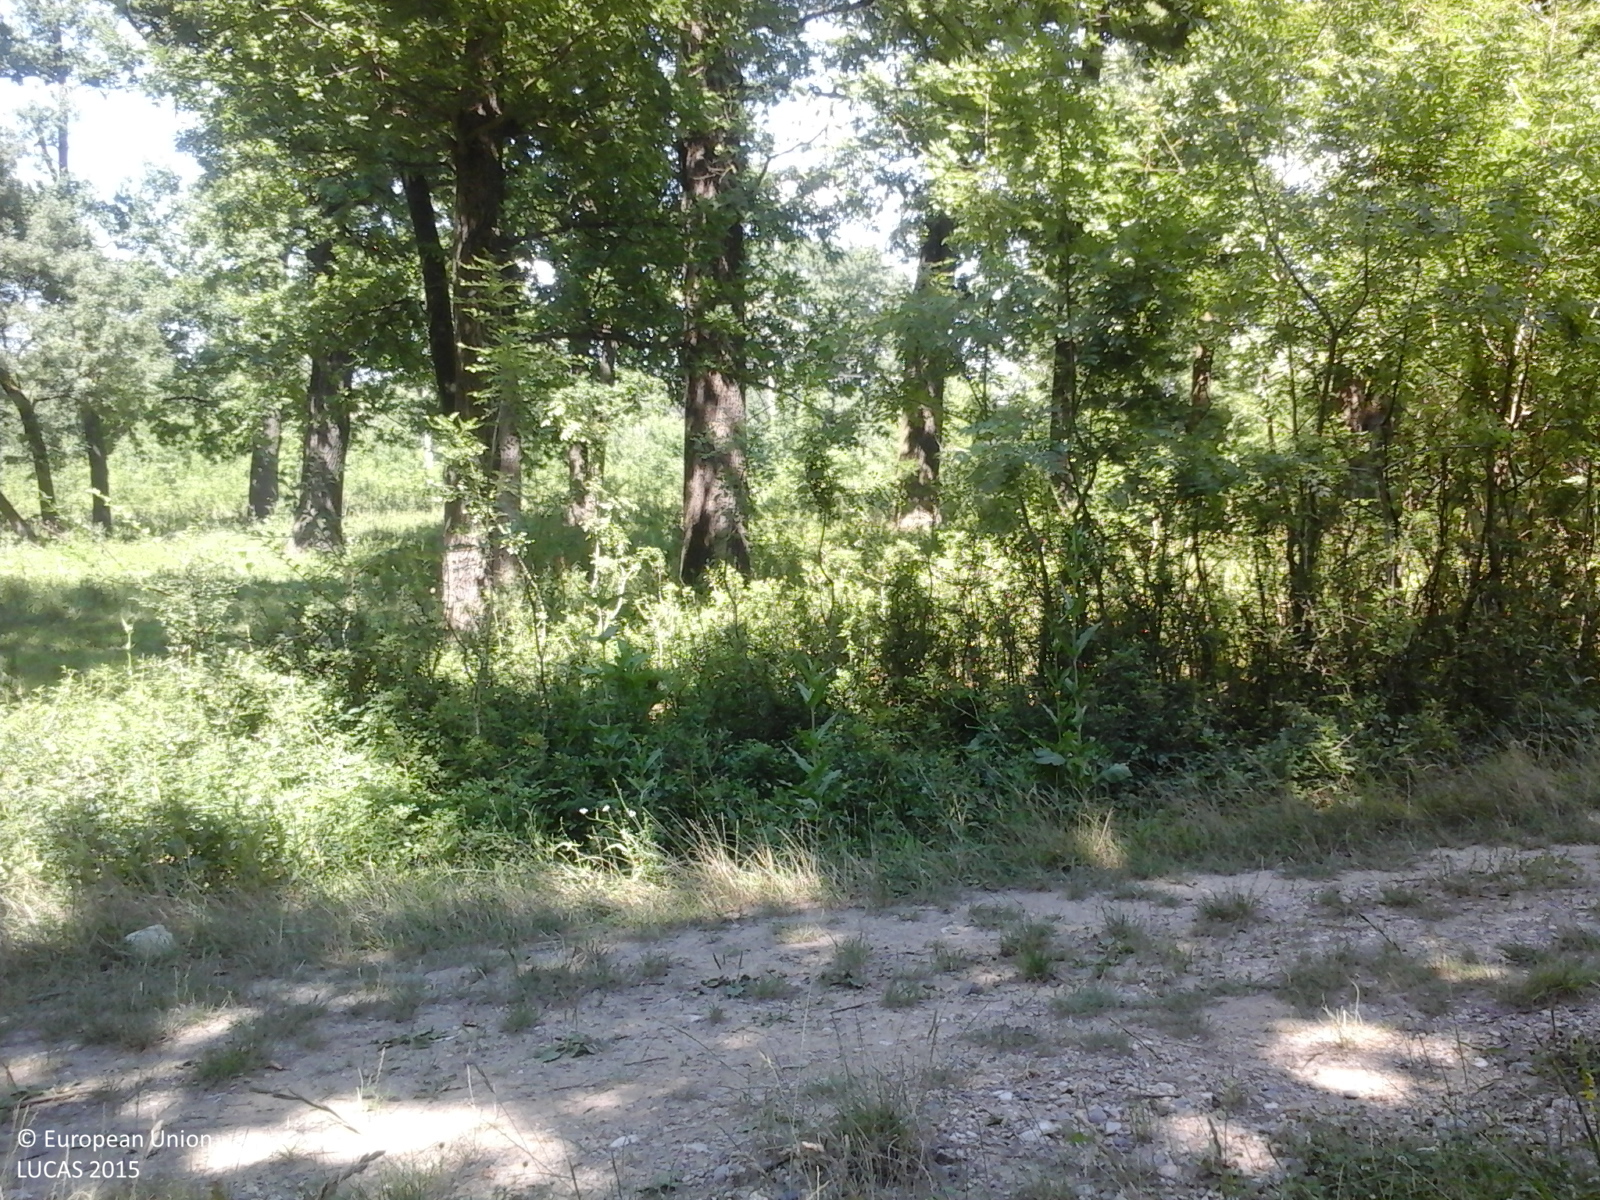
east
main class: Grassland
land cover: Spontaneously vegetated surfaces
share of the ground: > 75 %
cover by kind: herbaceous plants 100 %
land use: Fallow land
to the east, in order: Spontaneously vegetated surfaces; Tracks; Grassland without tree/shrub cover; Electric lines; Spontaneously vegetated surfaces; Rivers and streams; Broadleaved woodland; Arable land (only in case pi); Electric lines; Arable land (only in case pi); Broadleaved woodland; Grassland without tree/shrub cover; Abandoned hedges; Grassland without tree/shrub cover; Broadleaved woodland; Grassland without tree/shrub cover
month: July
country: RO
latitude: 44.1659
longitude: 24.5124
